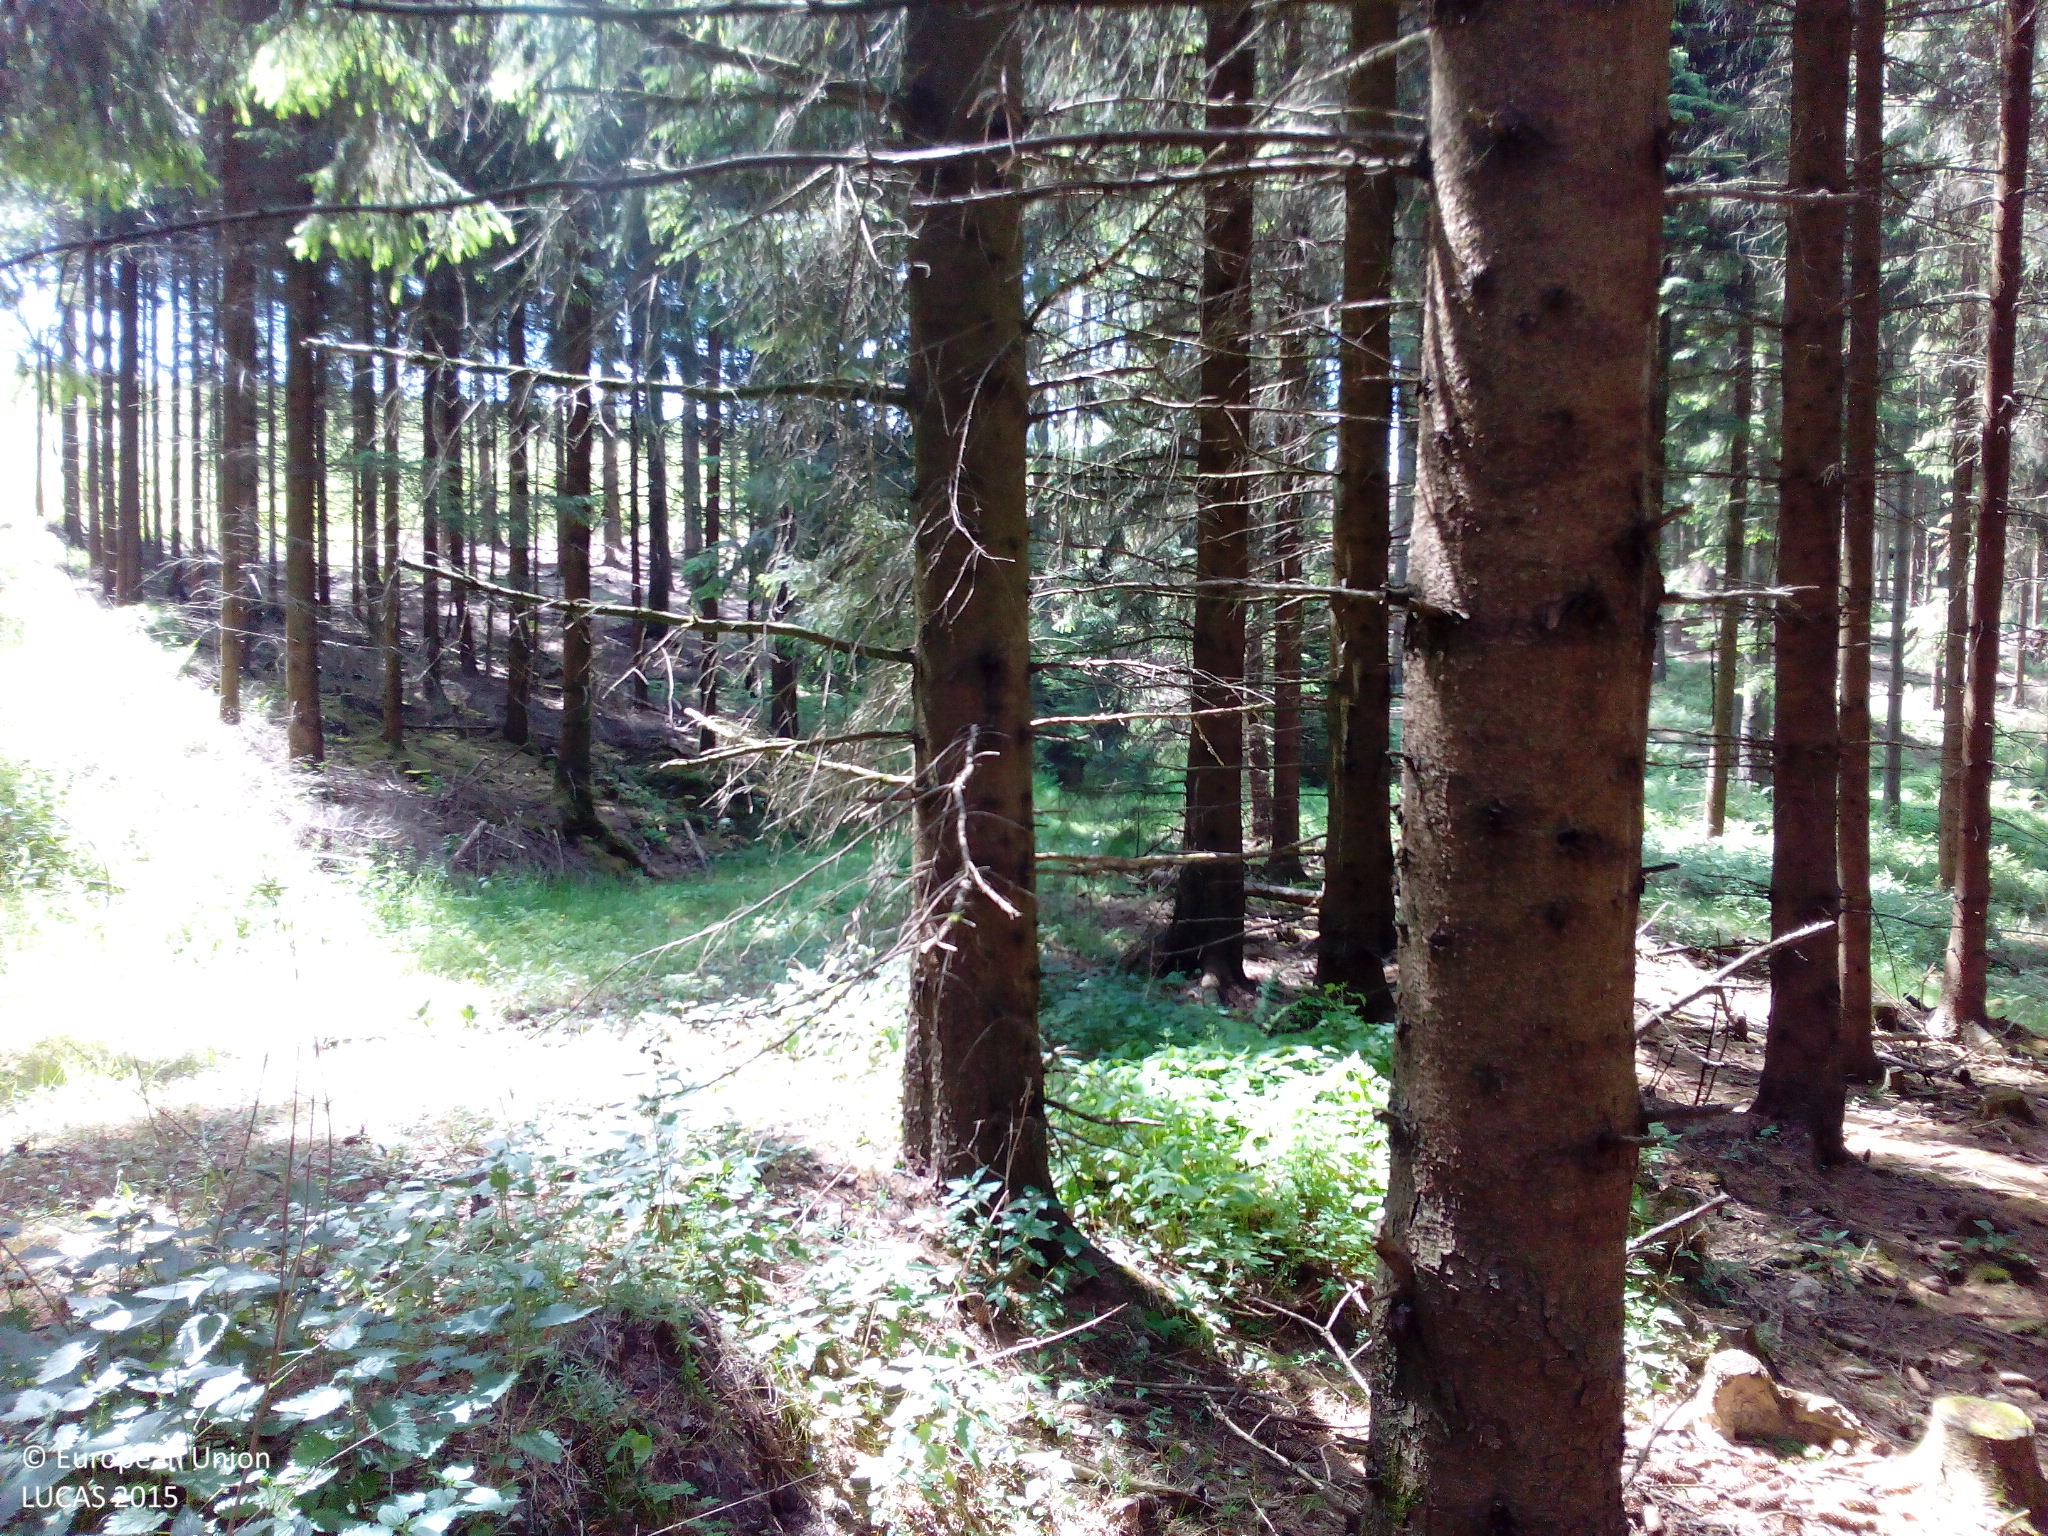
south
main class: Woodland
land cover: Spruce dominated coniferous woodland
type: hemiboreal forest and nemoral coniferous forest and mixed broadleaved-coniferous forest
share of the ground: > 75 %
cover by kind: coniferous forest trees 100 %
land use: Forestry
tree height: > 5 m
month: June
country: DE
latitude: 51.4869
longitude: 8.4882
